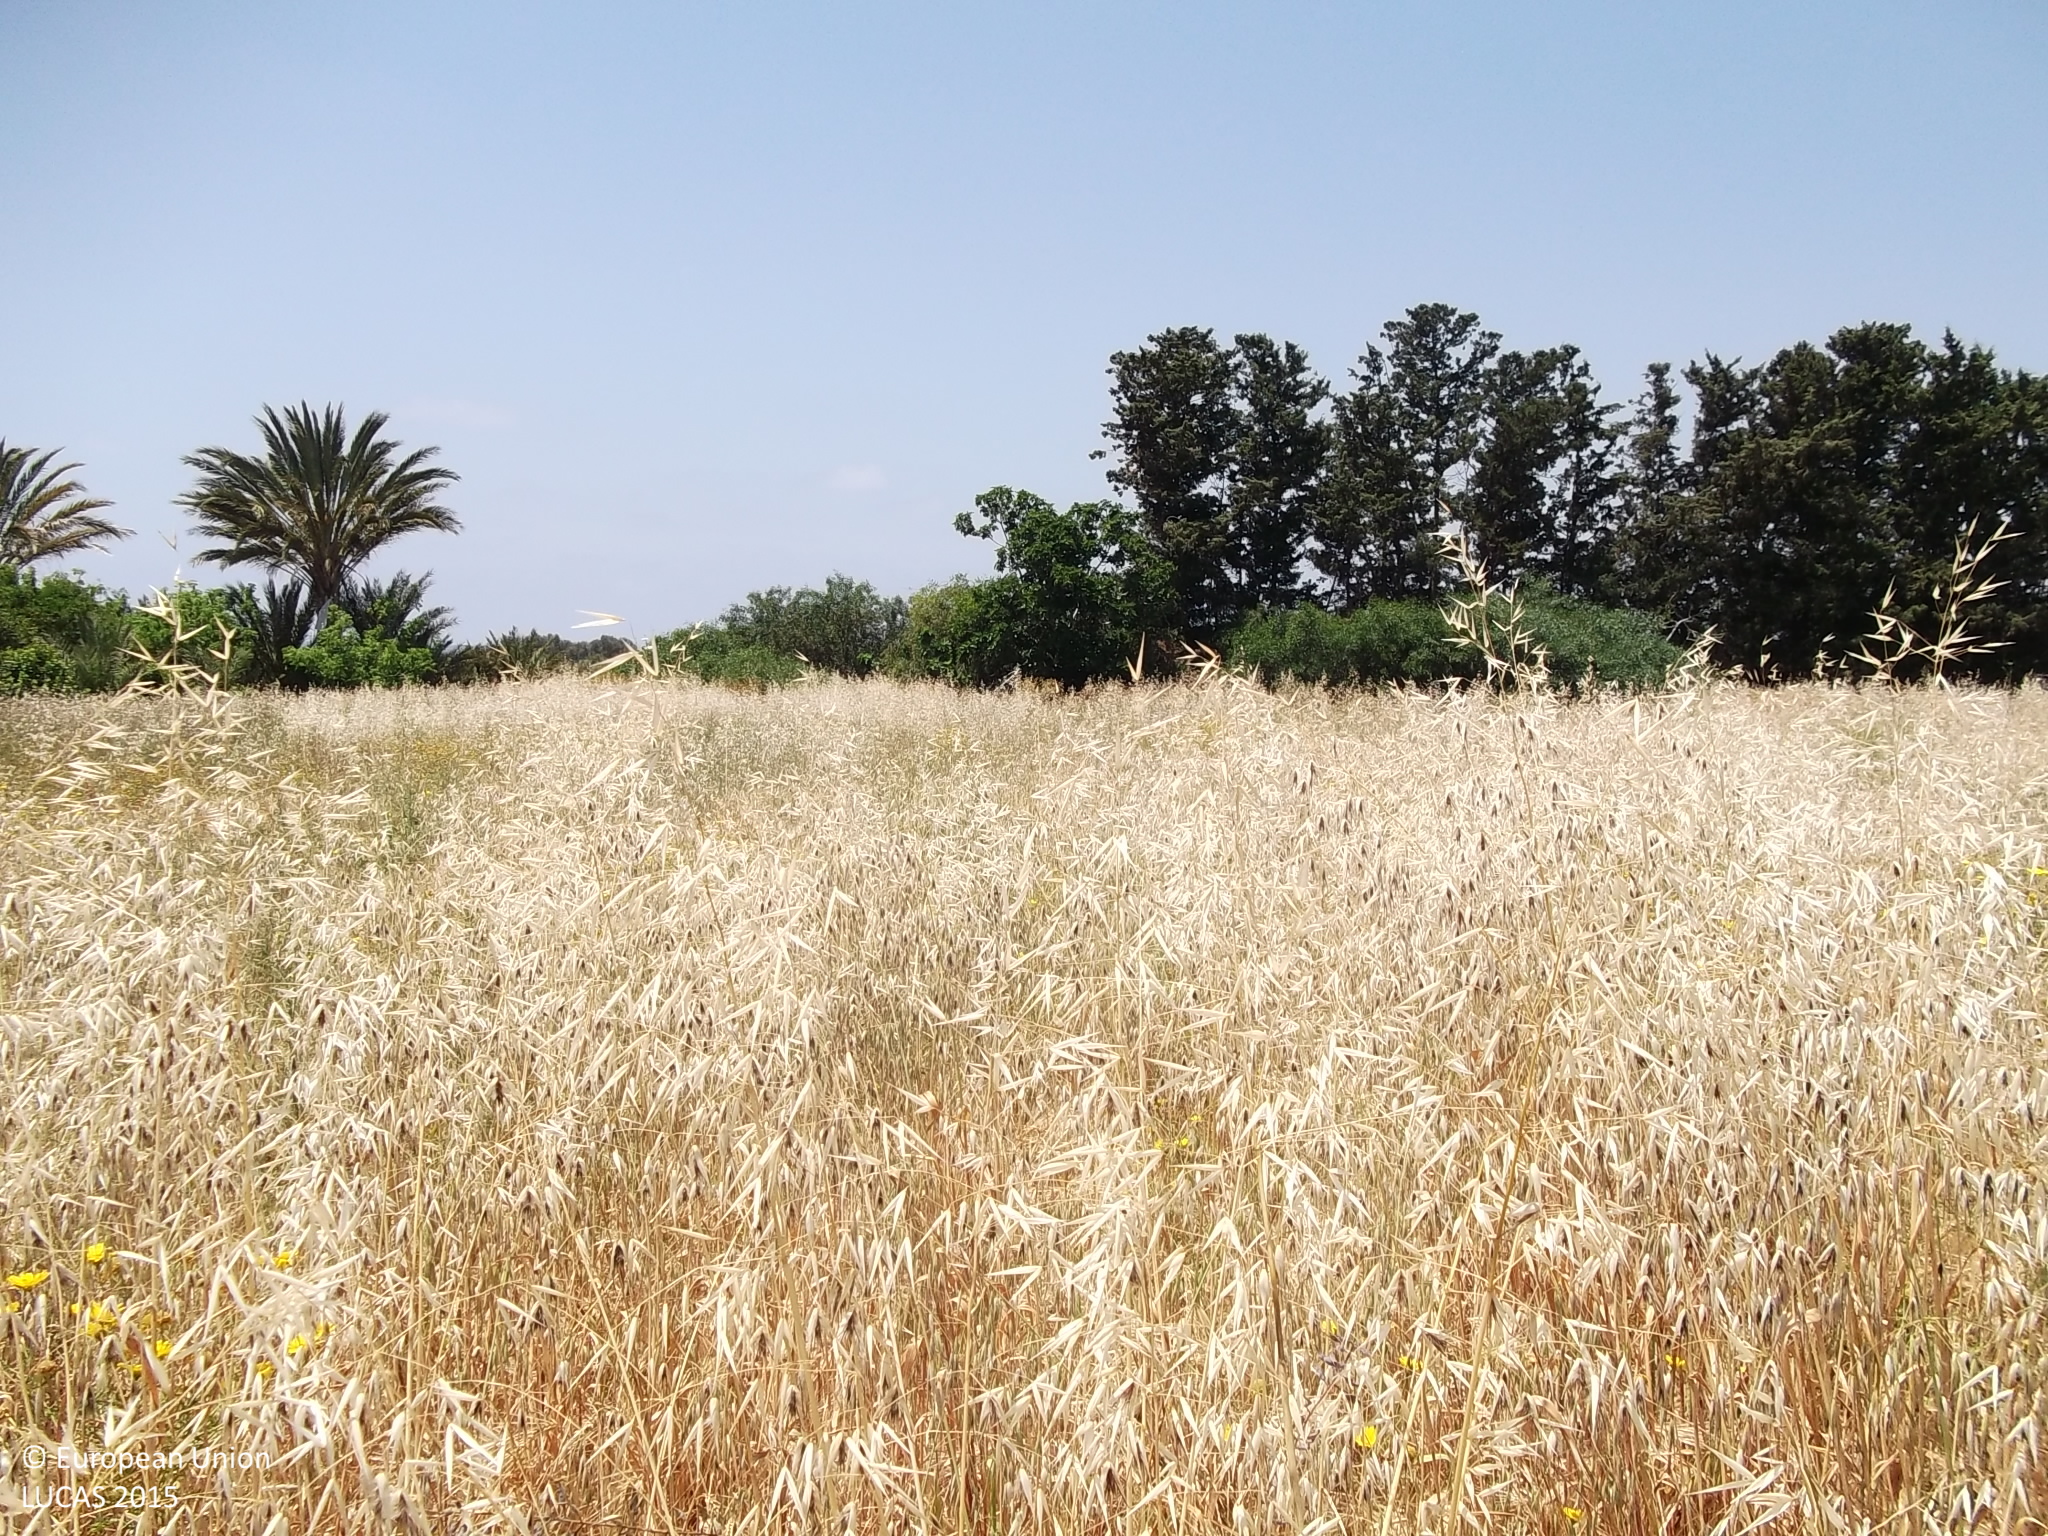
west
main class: Cropland
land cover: Mixed cereals for fodder
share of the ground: > 75 %
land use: Agriculture (excluding fallow land and kitchen gardens)
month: May
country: CY
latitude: 34.6993
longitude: 32.5597
